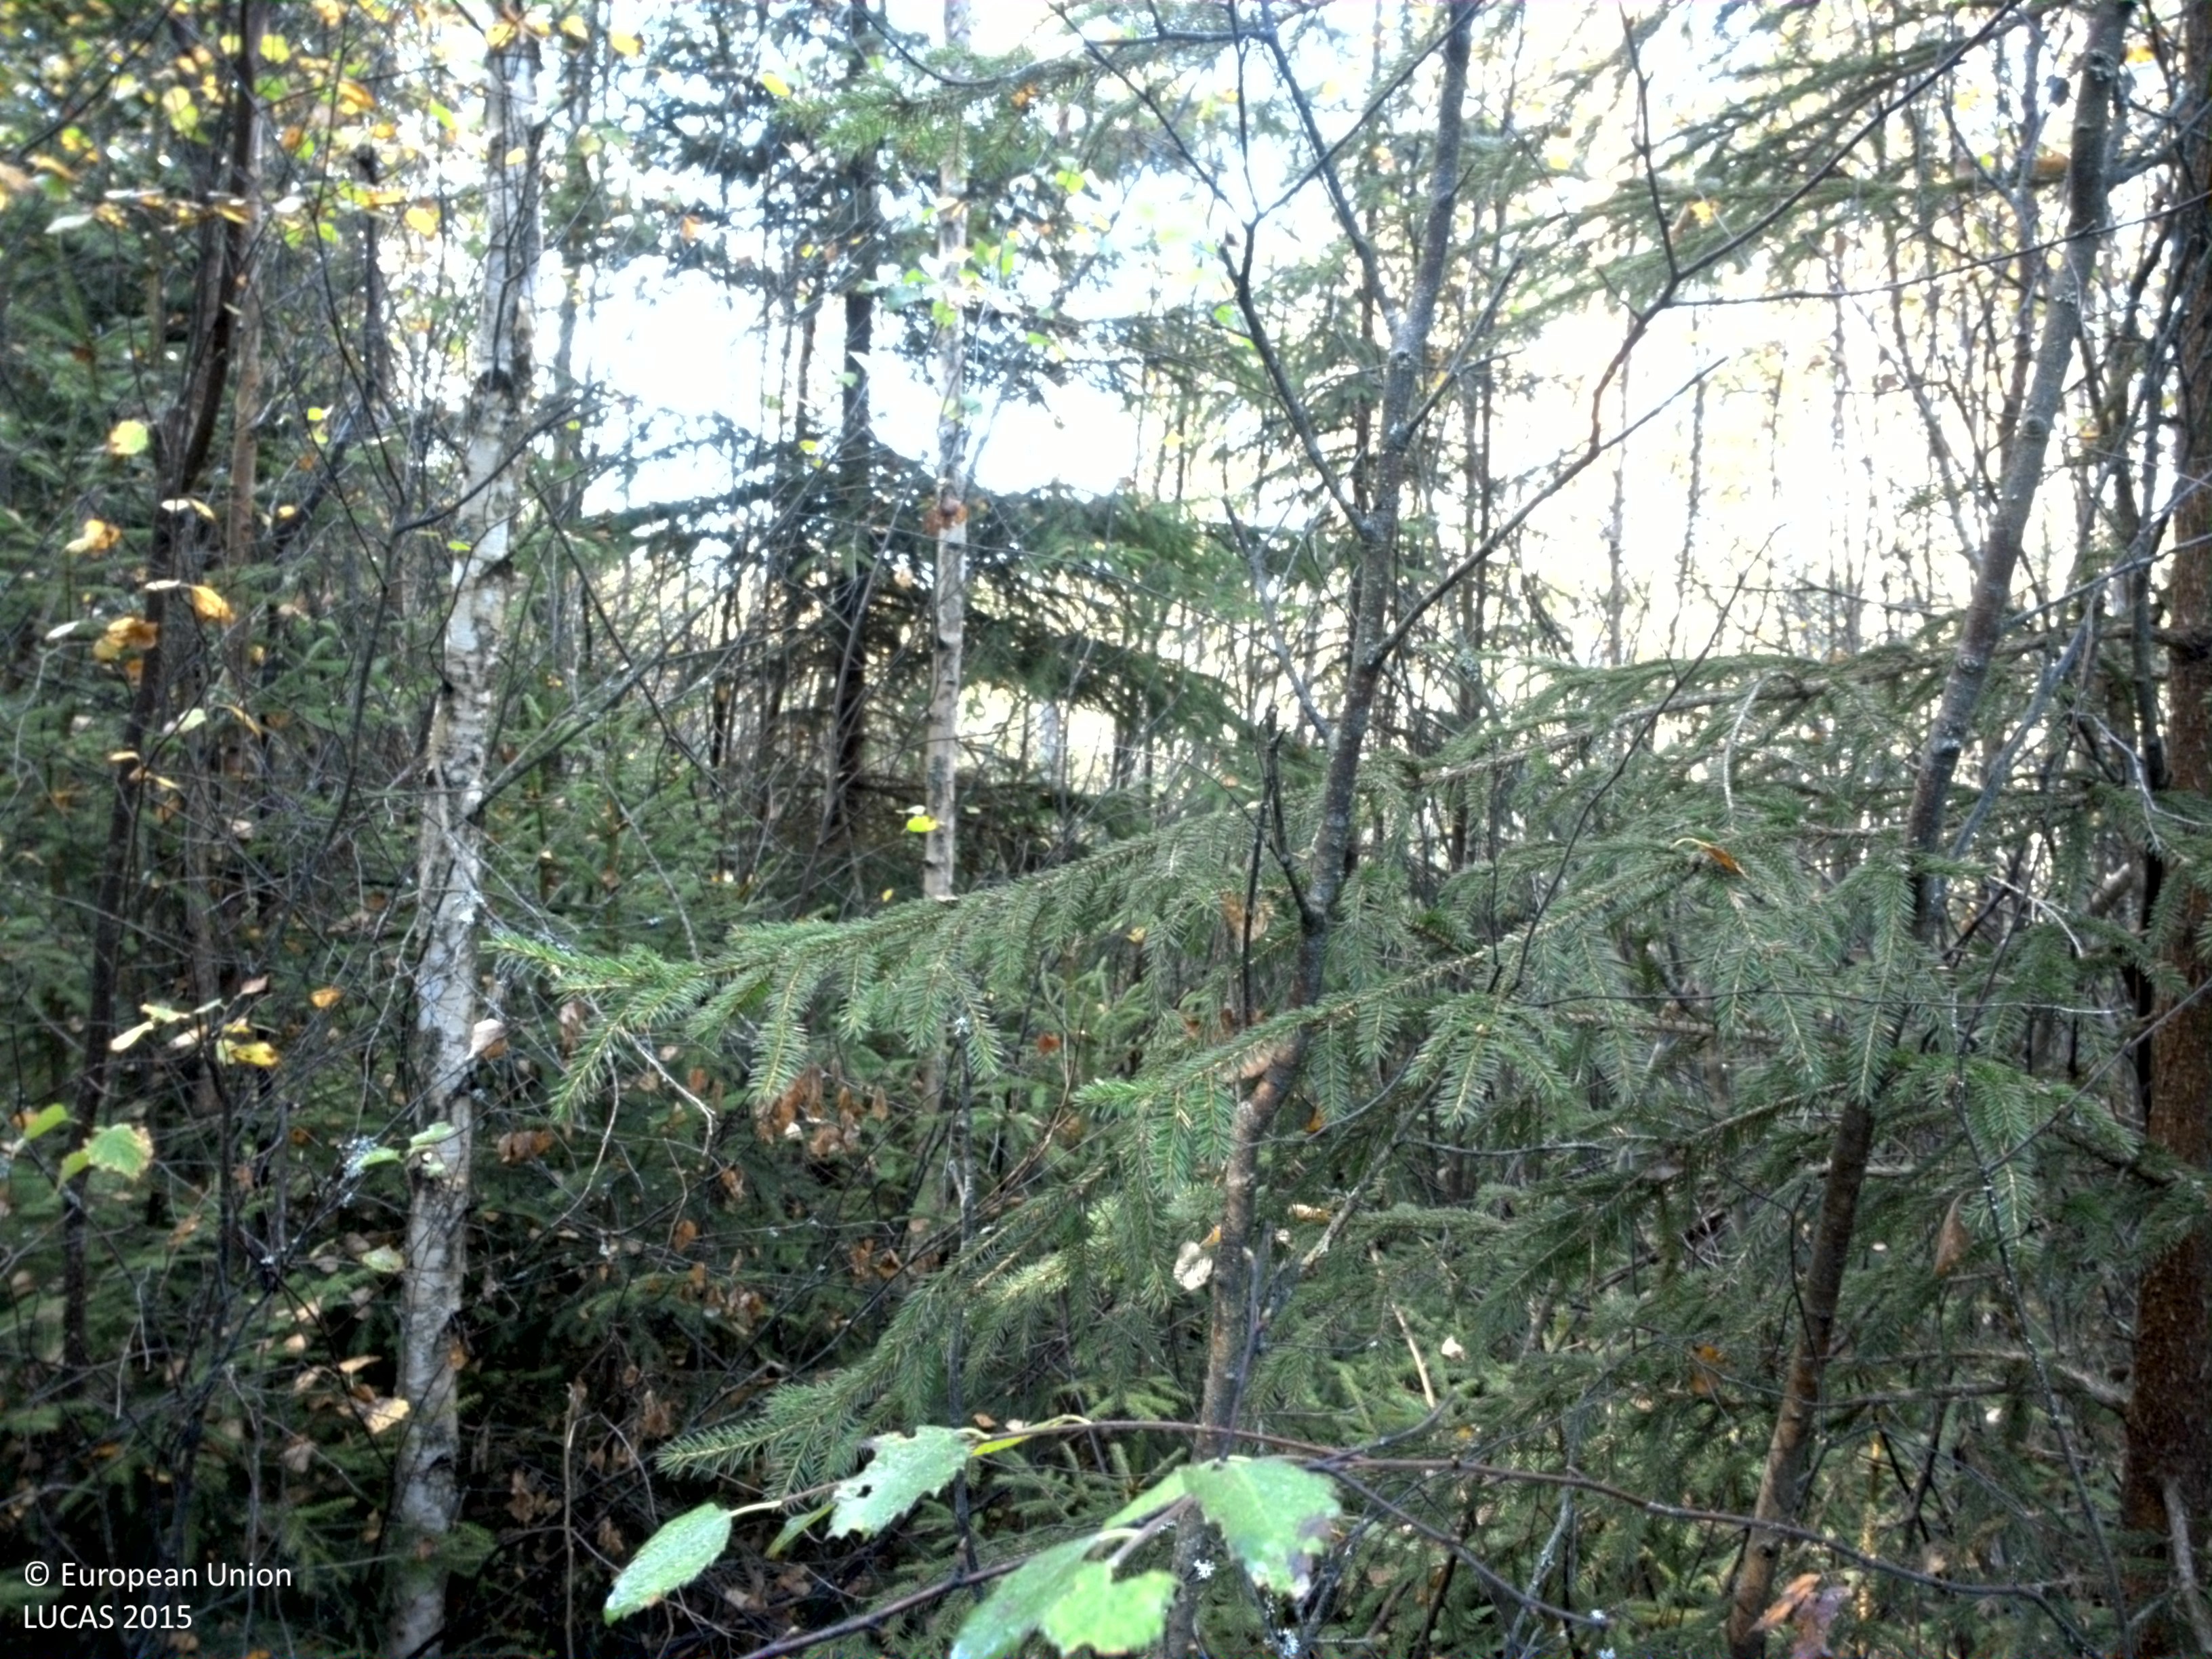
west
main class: Woodland
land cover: Spruce dominated mixed woodland
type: boreal forest
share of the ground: 50 - 75 %
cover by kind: coniferous forest trees 30 %, broadleaved forest trees 30 %, herbaceous plants 15 %, lichens and mosses 15 %, shrubs 10 %
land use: Forestry
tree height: > 5 m
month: September
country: SE
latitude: 59.2007
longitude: 14.1417
